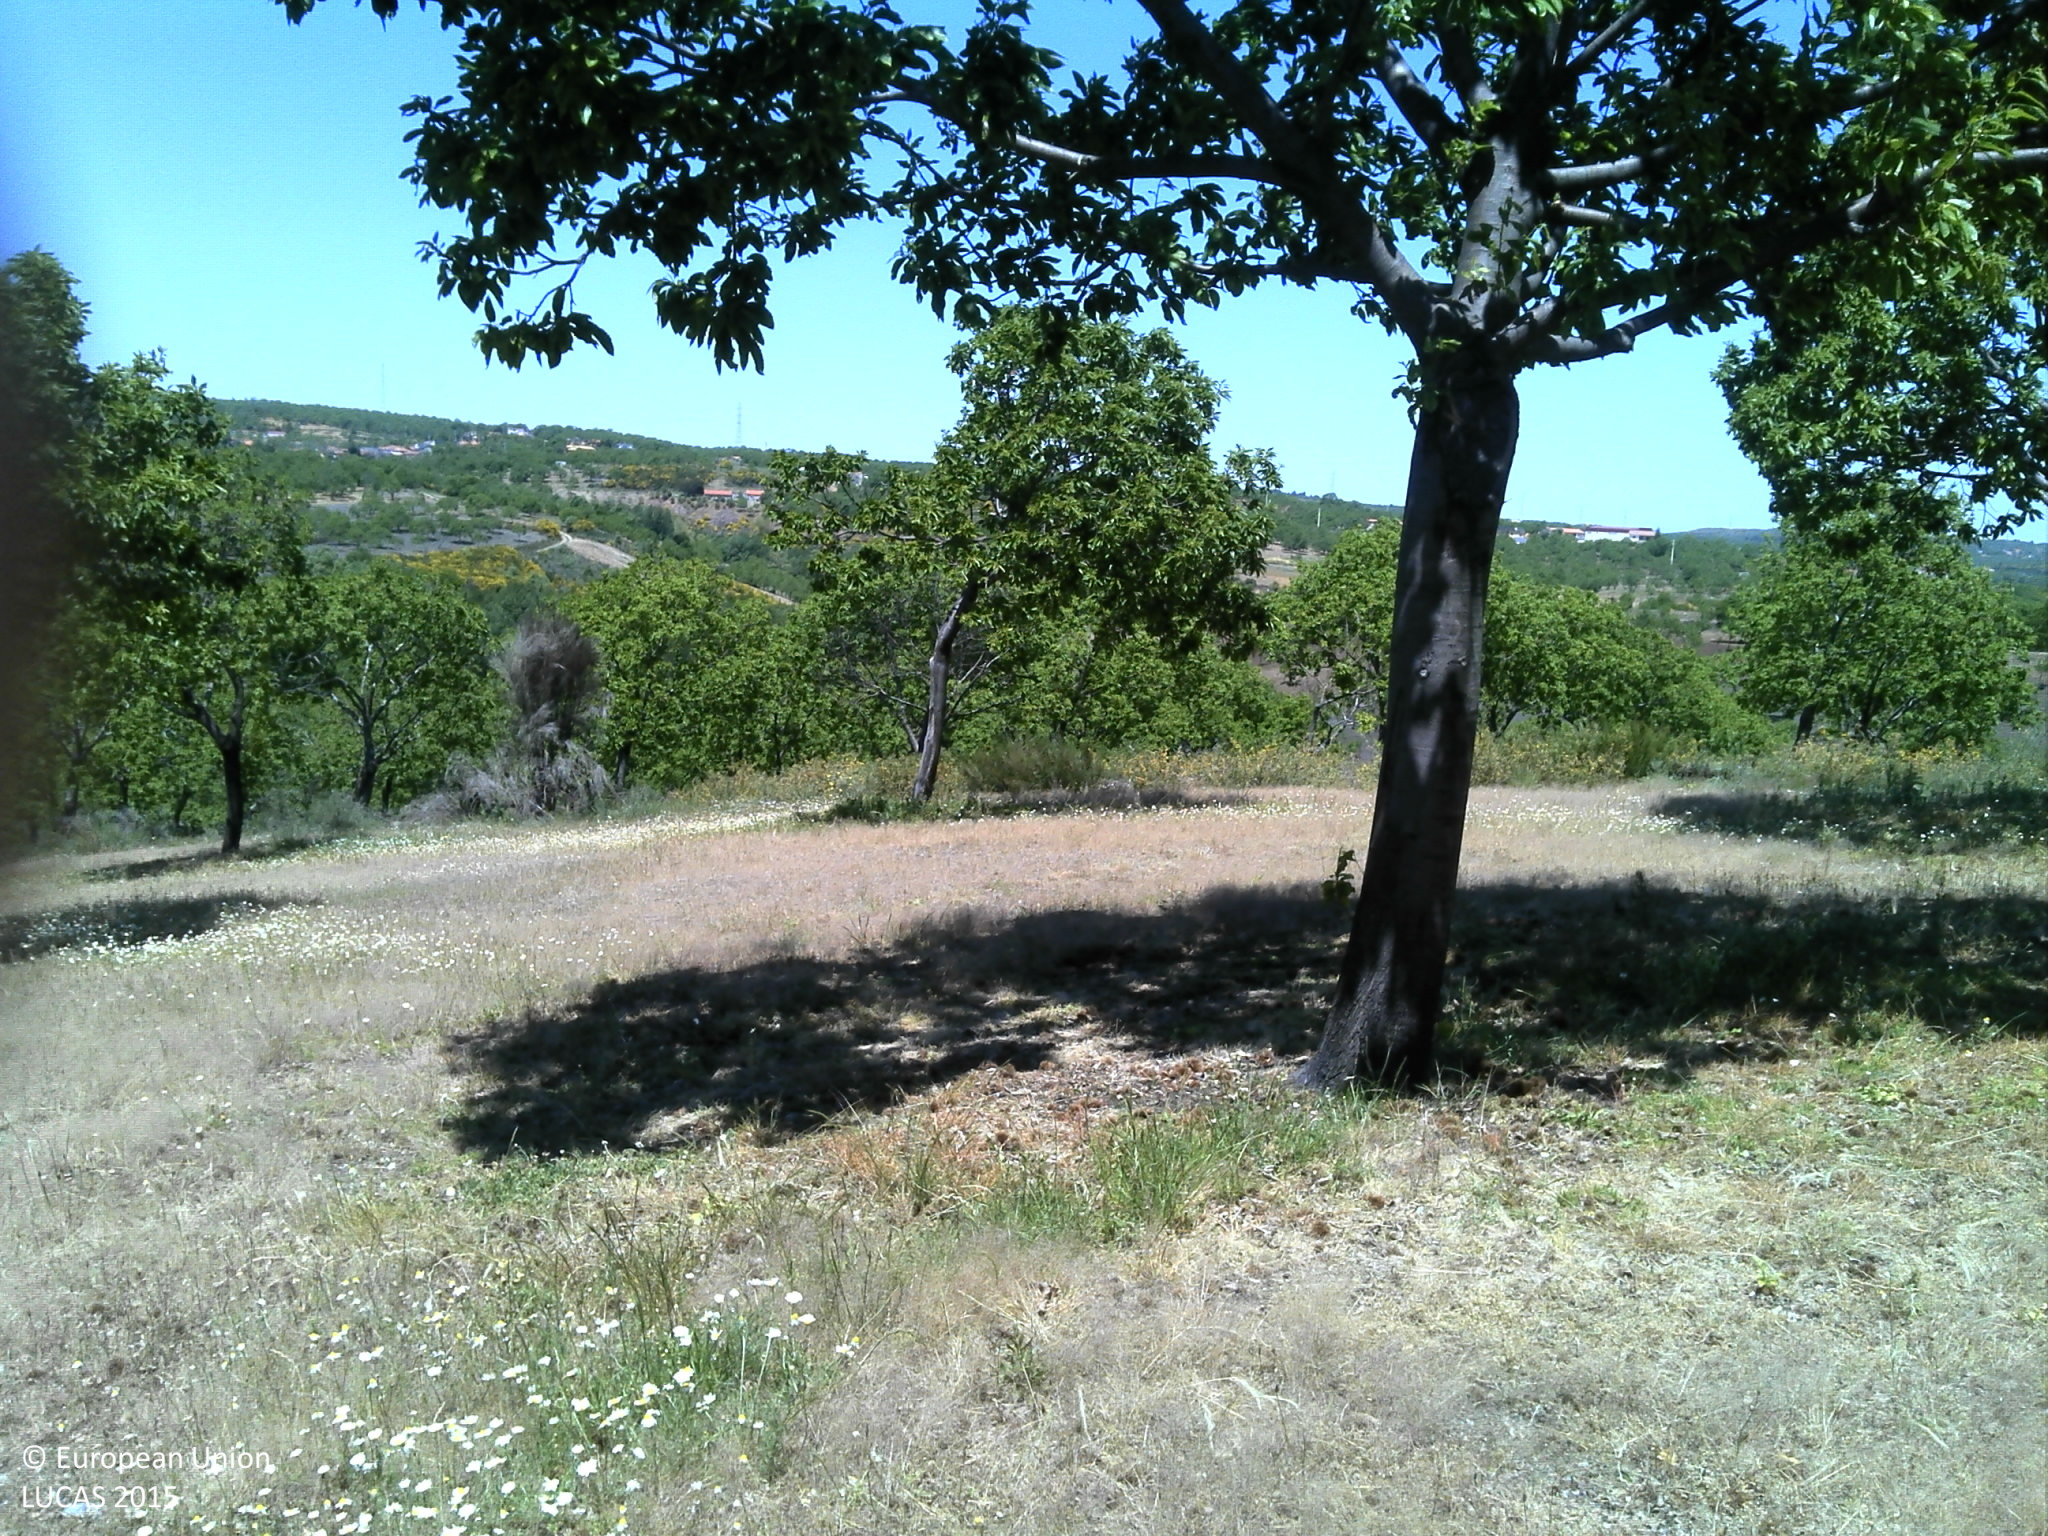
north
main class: Cropland
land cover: Nuts trees
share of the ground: 25 - 50 %
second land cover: Spontaneously vegetated surfaces
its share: 10 - 25 %
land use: Agriculture (excluding fallow land and kitchen gardens)
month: May
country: PT
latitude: 41.5627
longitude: -7.4787
